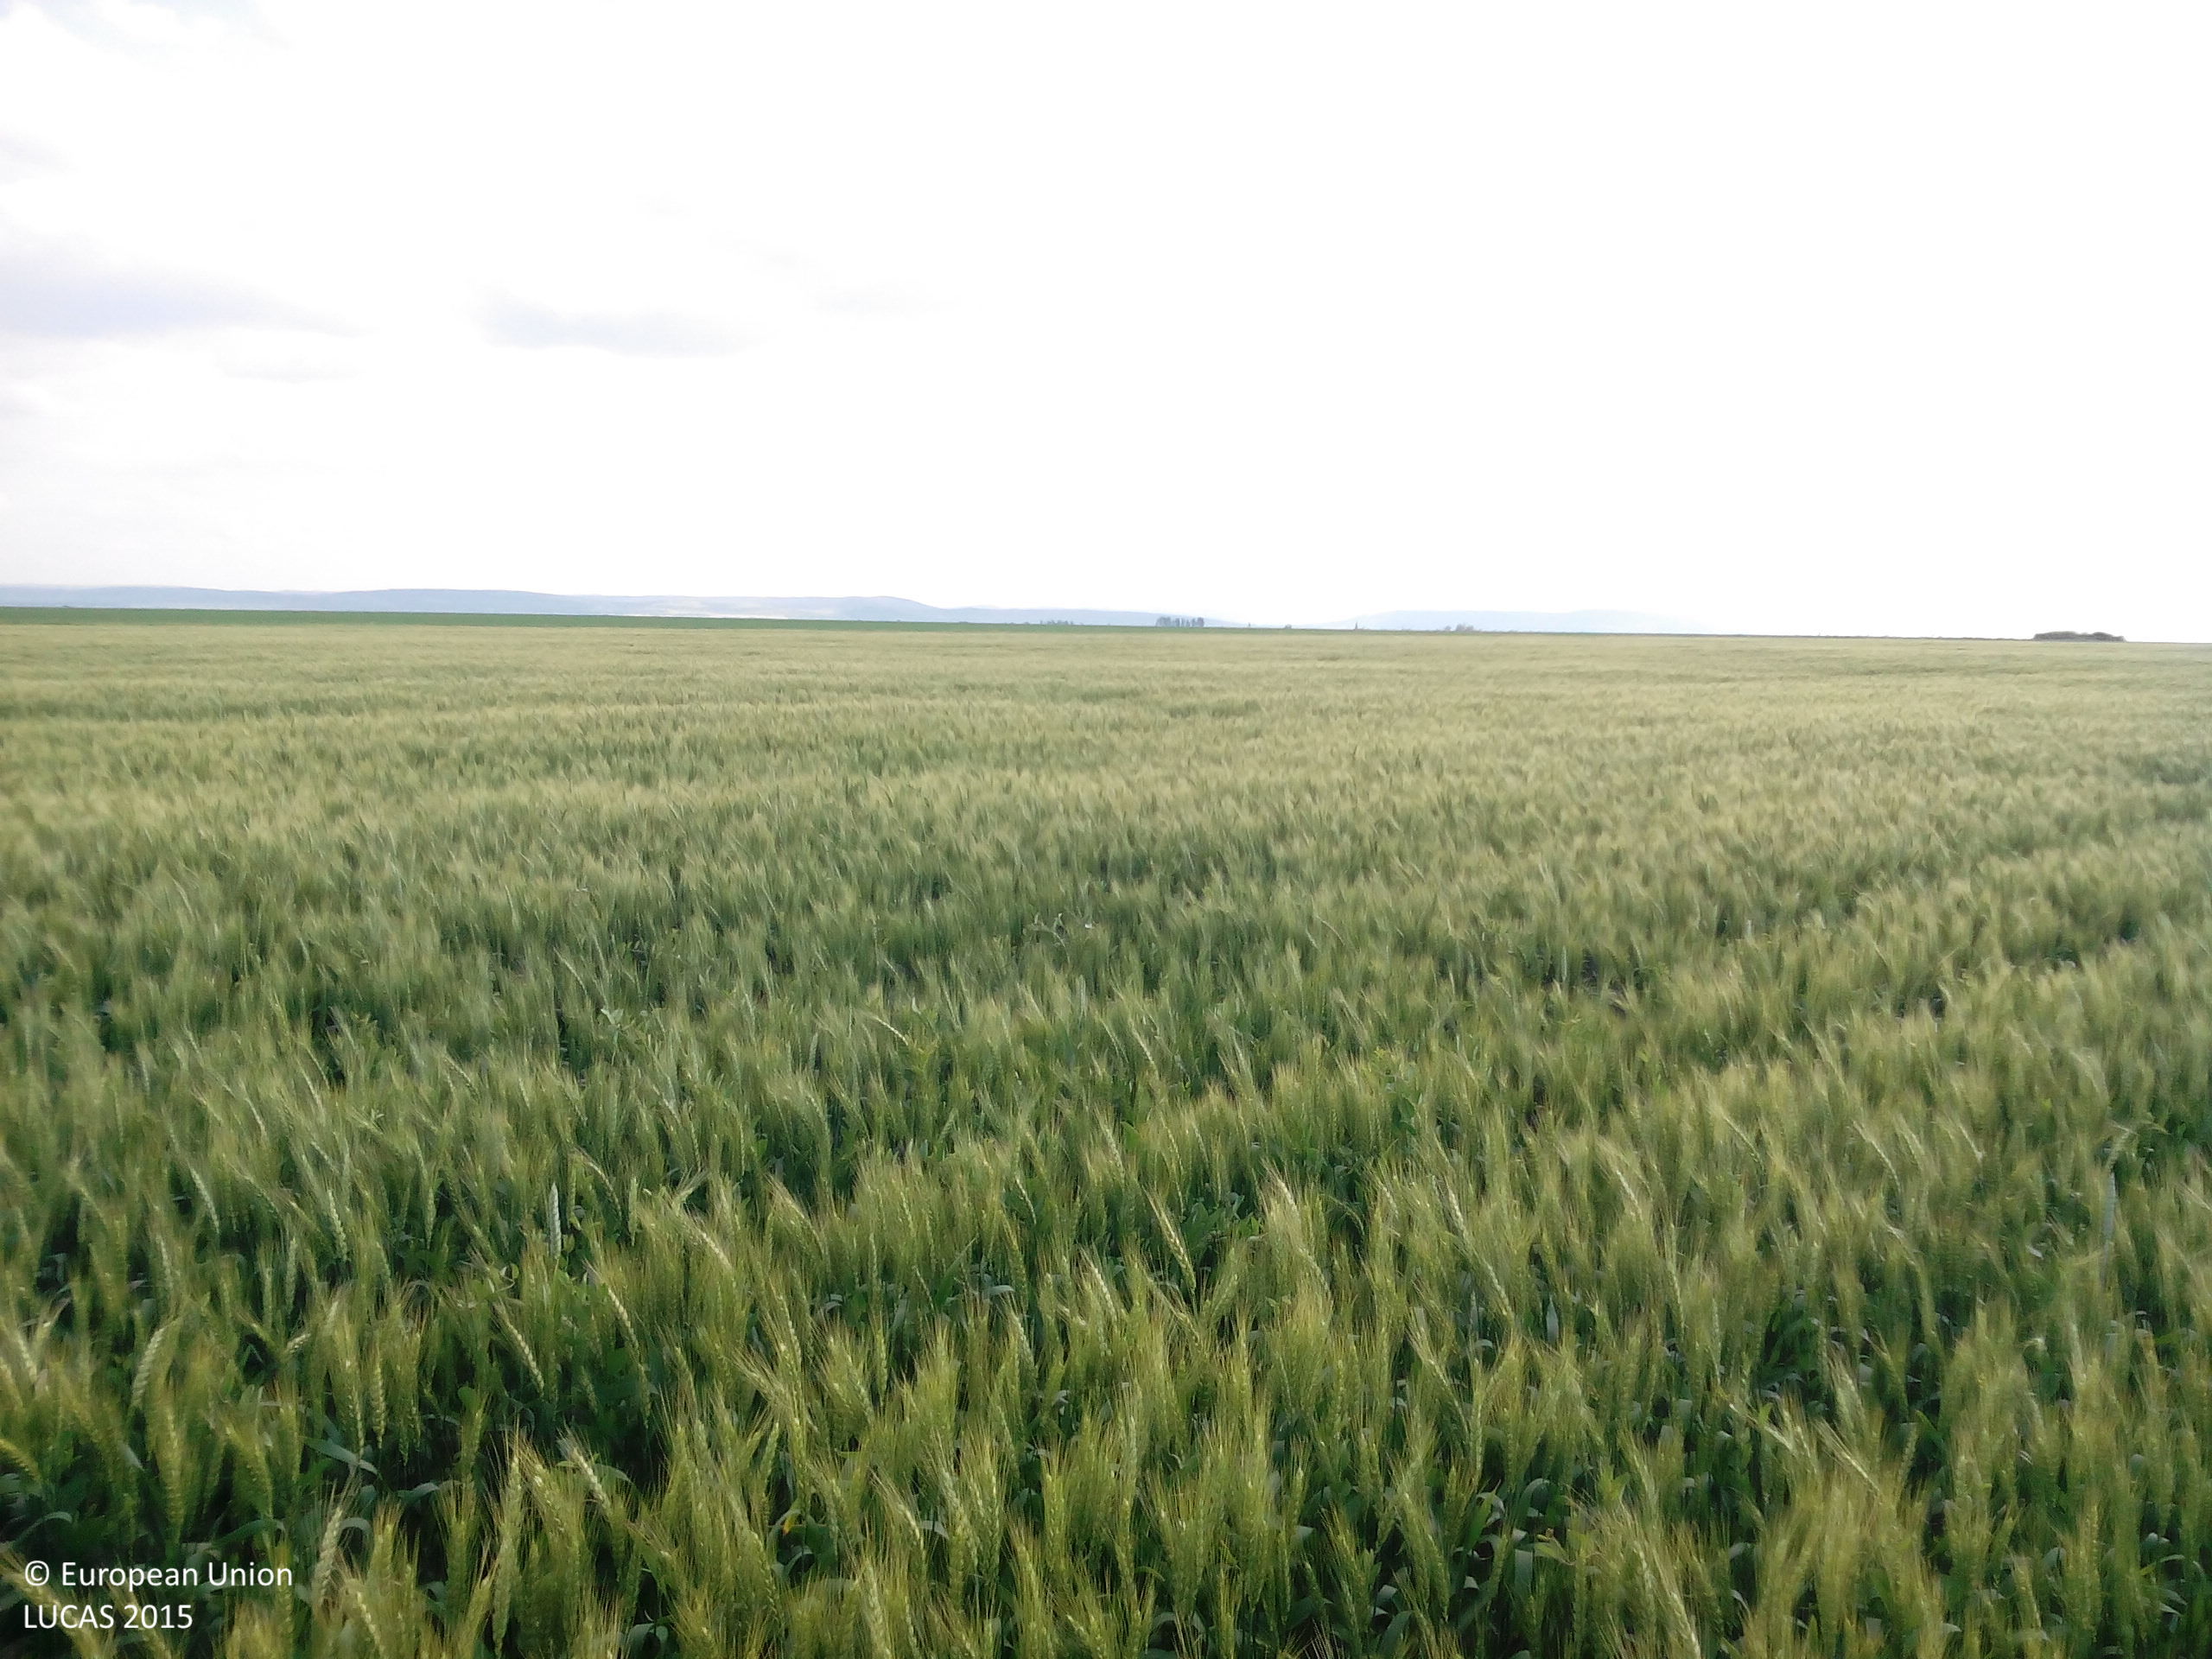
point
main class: Cropland
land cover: Common wheat
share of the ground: > 75 %
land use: Agriculture (excluding fallow land and kitchen gardens)
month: May
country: BG
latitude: 43.4704
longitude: 23.8578
